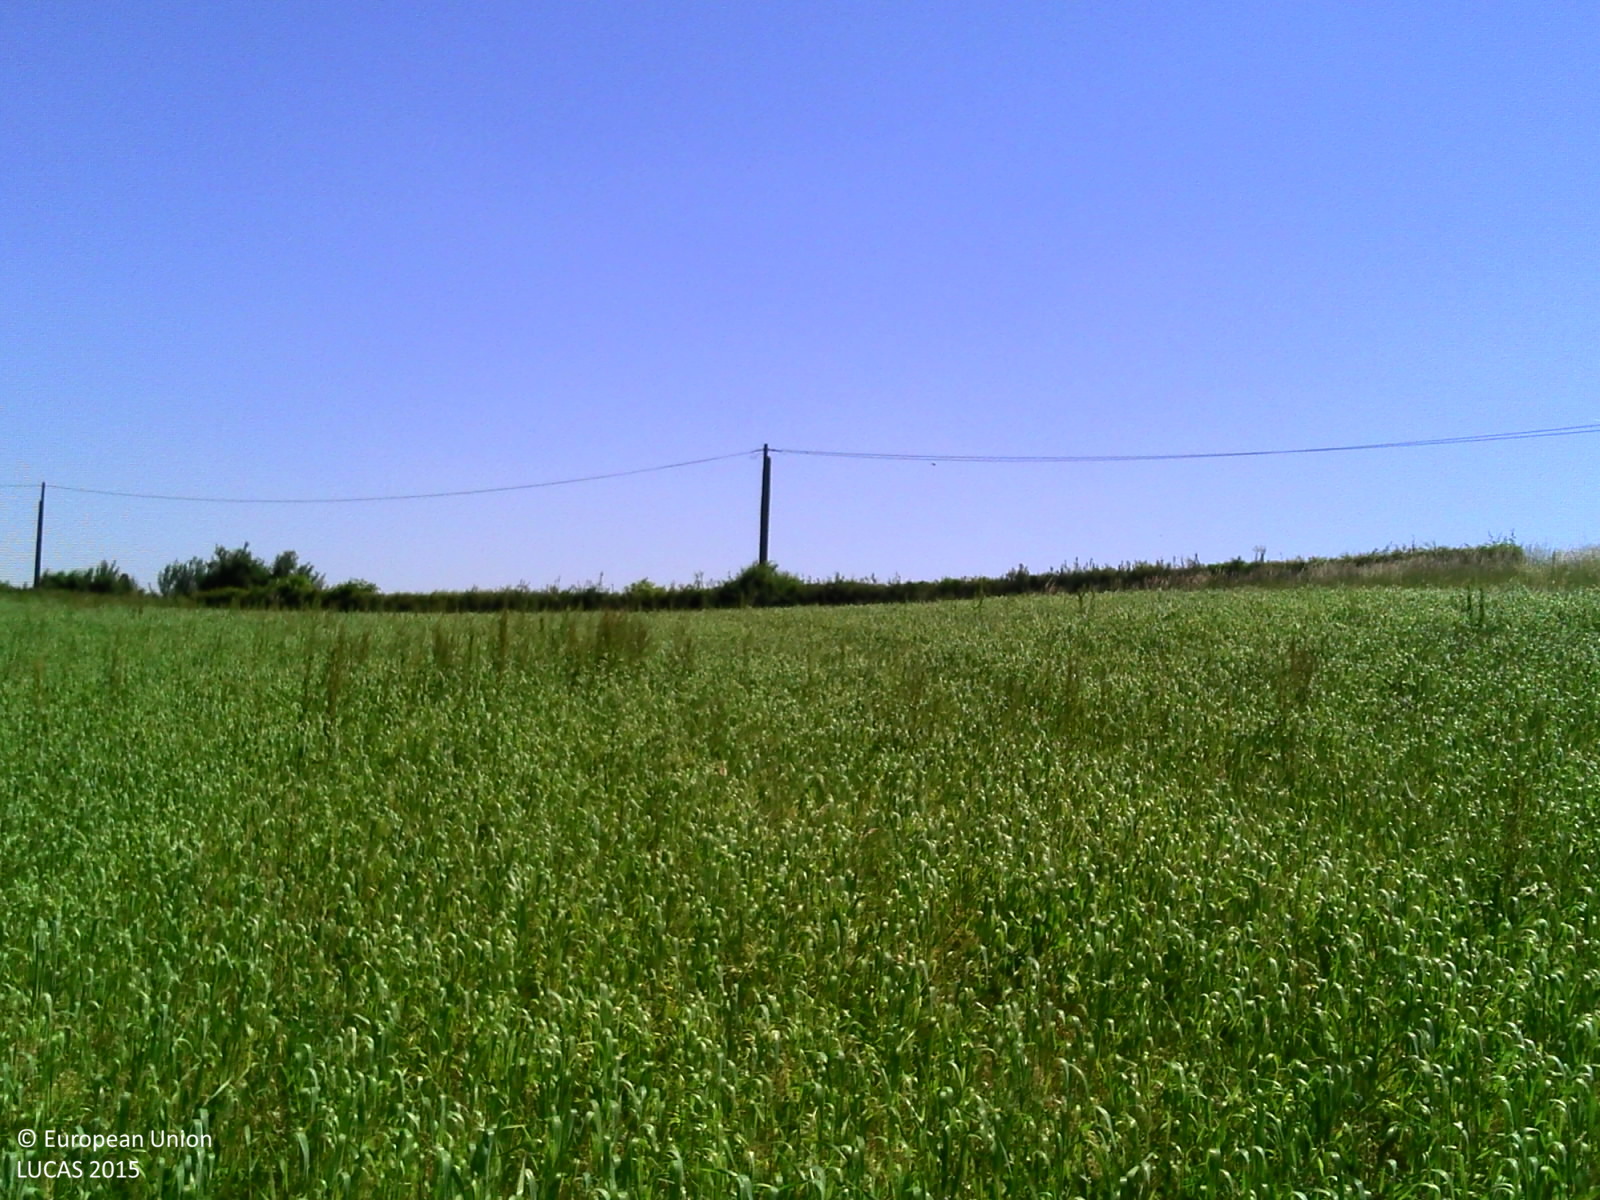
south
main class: Cropland
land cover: Barley
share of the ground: > 75 %
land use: Agriculture (excluding fallow land and kitchen gardens)
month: May
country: FR
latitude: 44.5394
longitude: 1.8822
